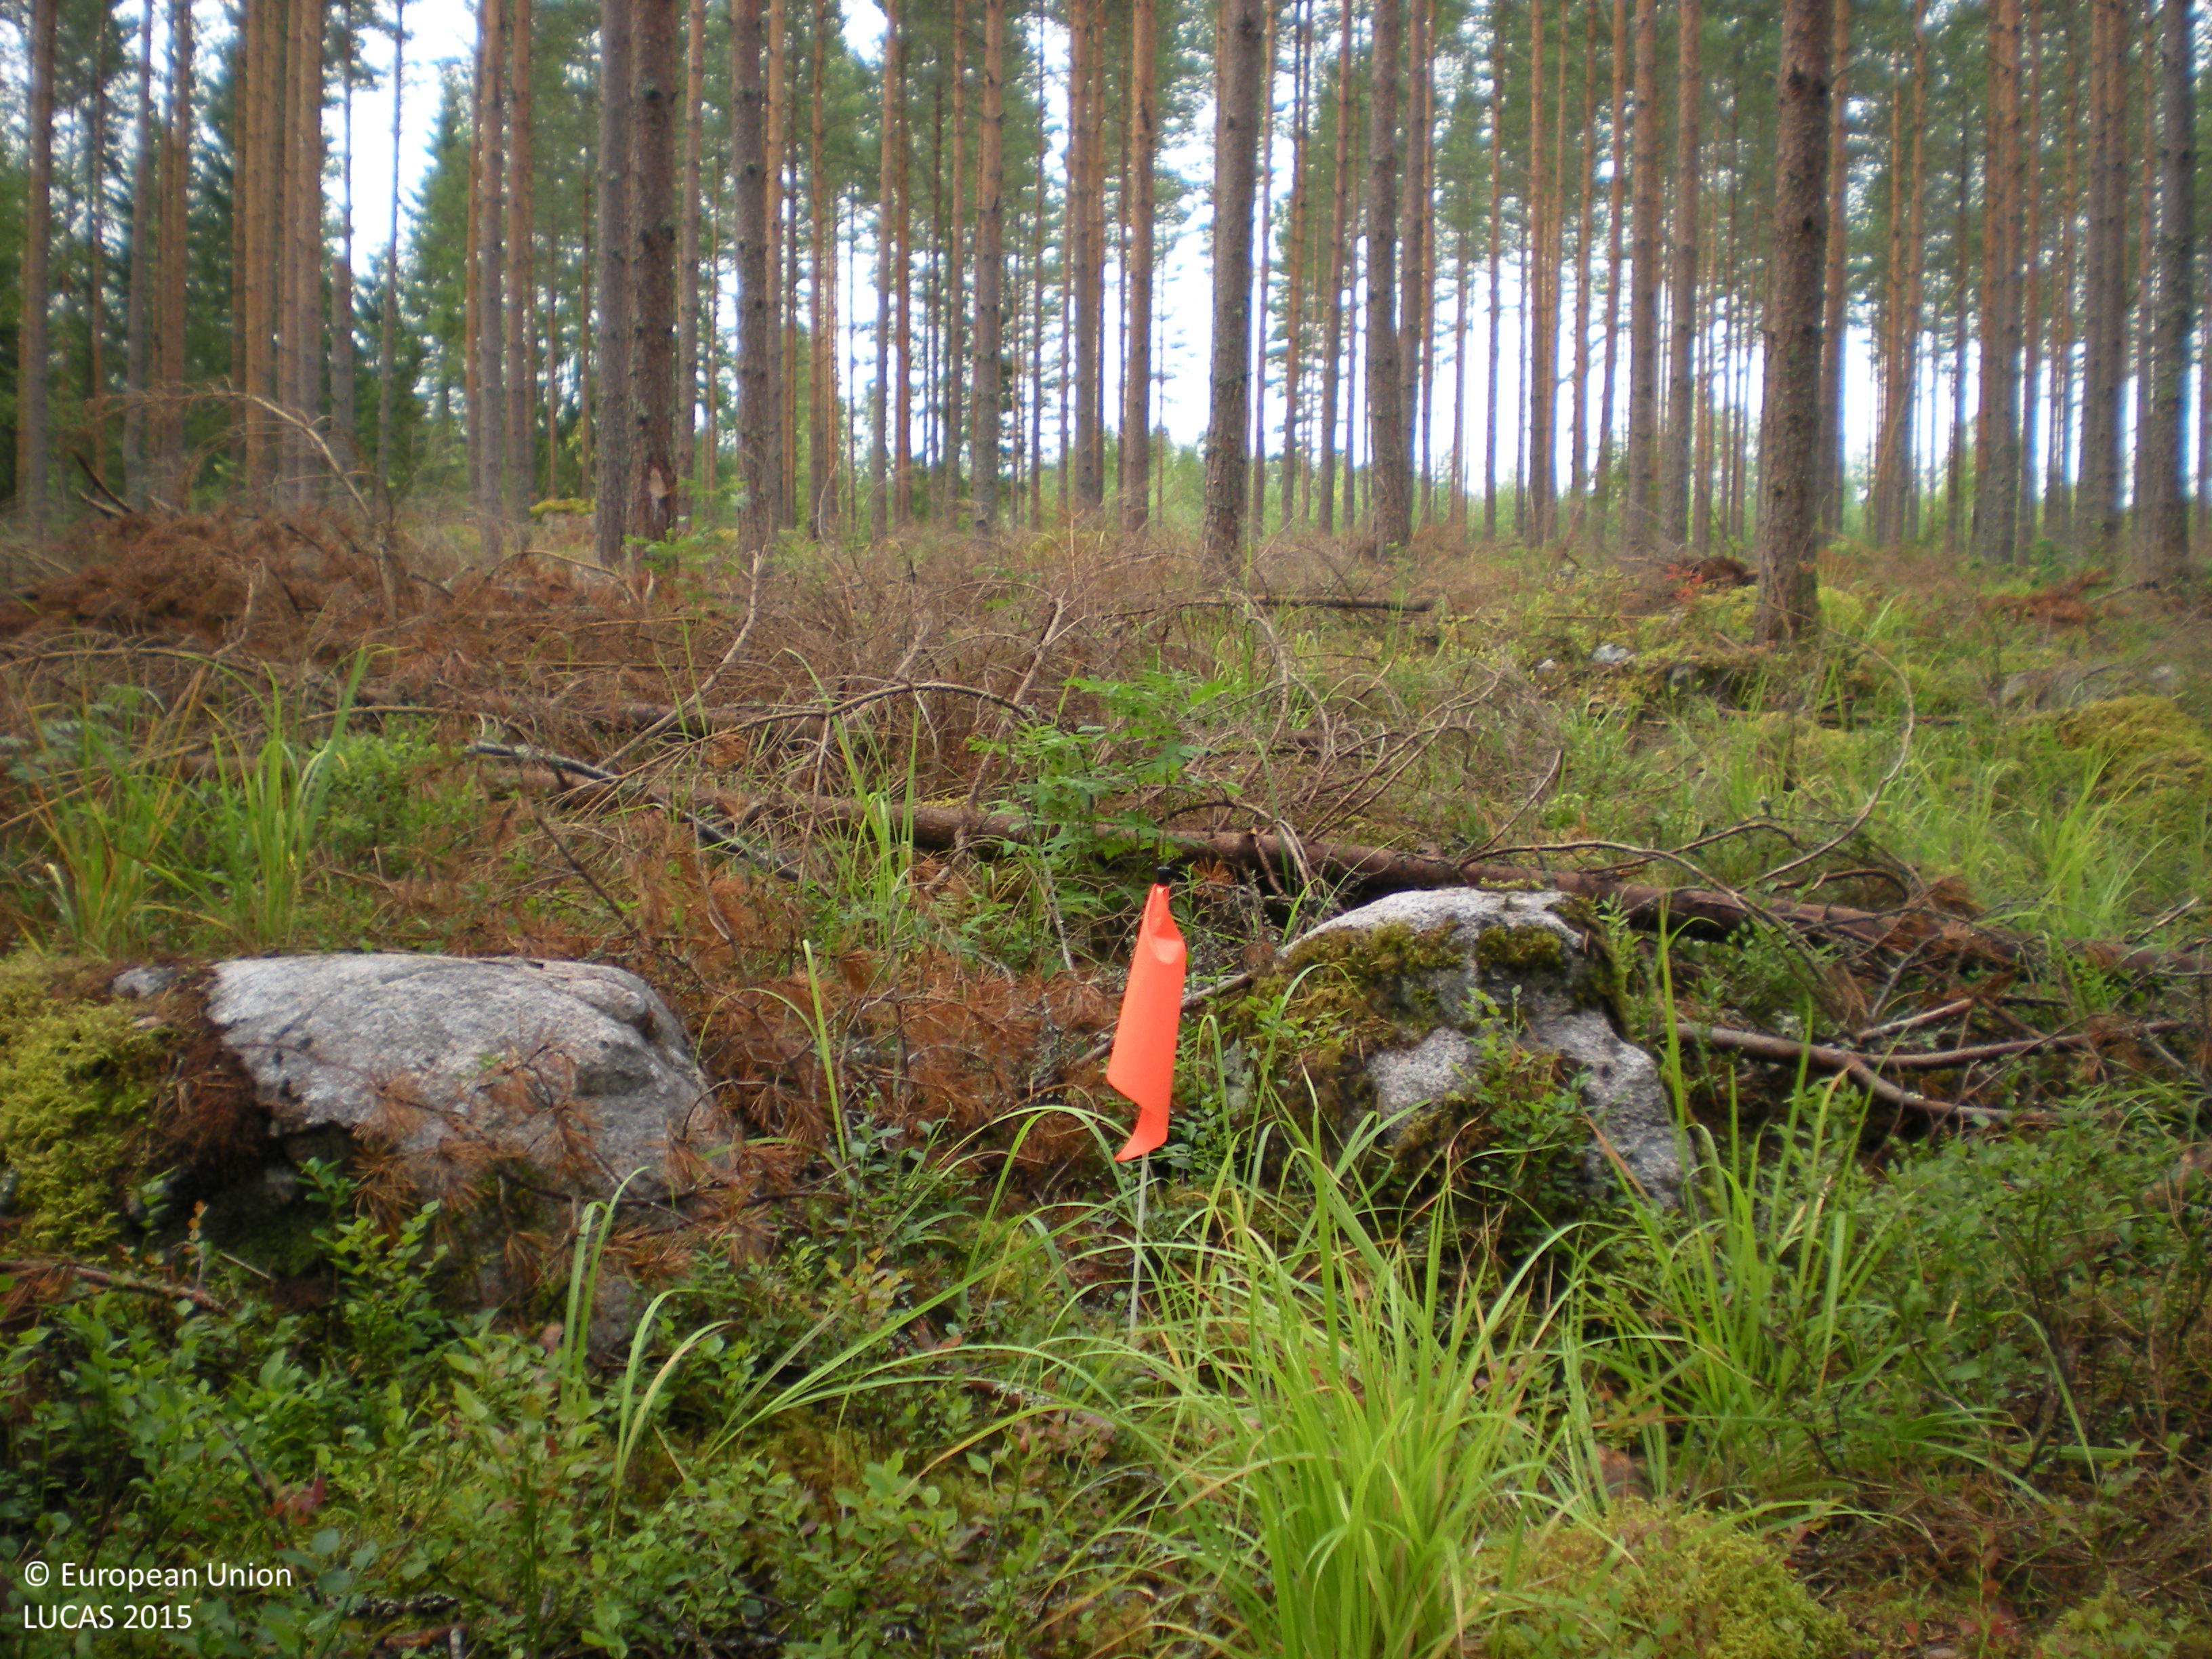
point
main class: Woodland
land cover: Pine dominated coniferous woodland
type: boreal forest
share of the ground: 50 - 75 %
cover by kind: coniferous forest trees 70 %, shrubs 10 %, herbaceous plants 5 %, lichens and mosses 5 %, consolidated bare surface 5 %
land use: Forestry
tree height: > 5 m
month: August
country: SE
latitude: 60.4683
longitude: 17.1743
